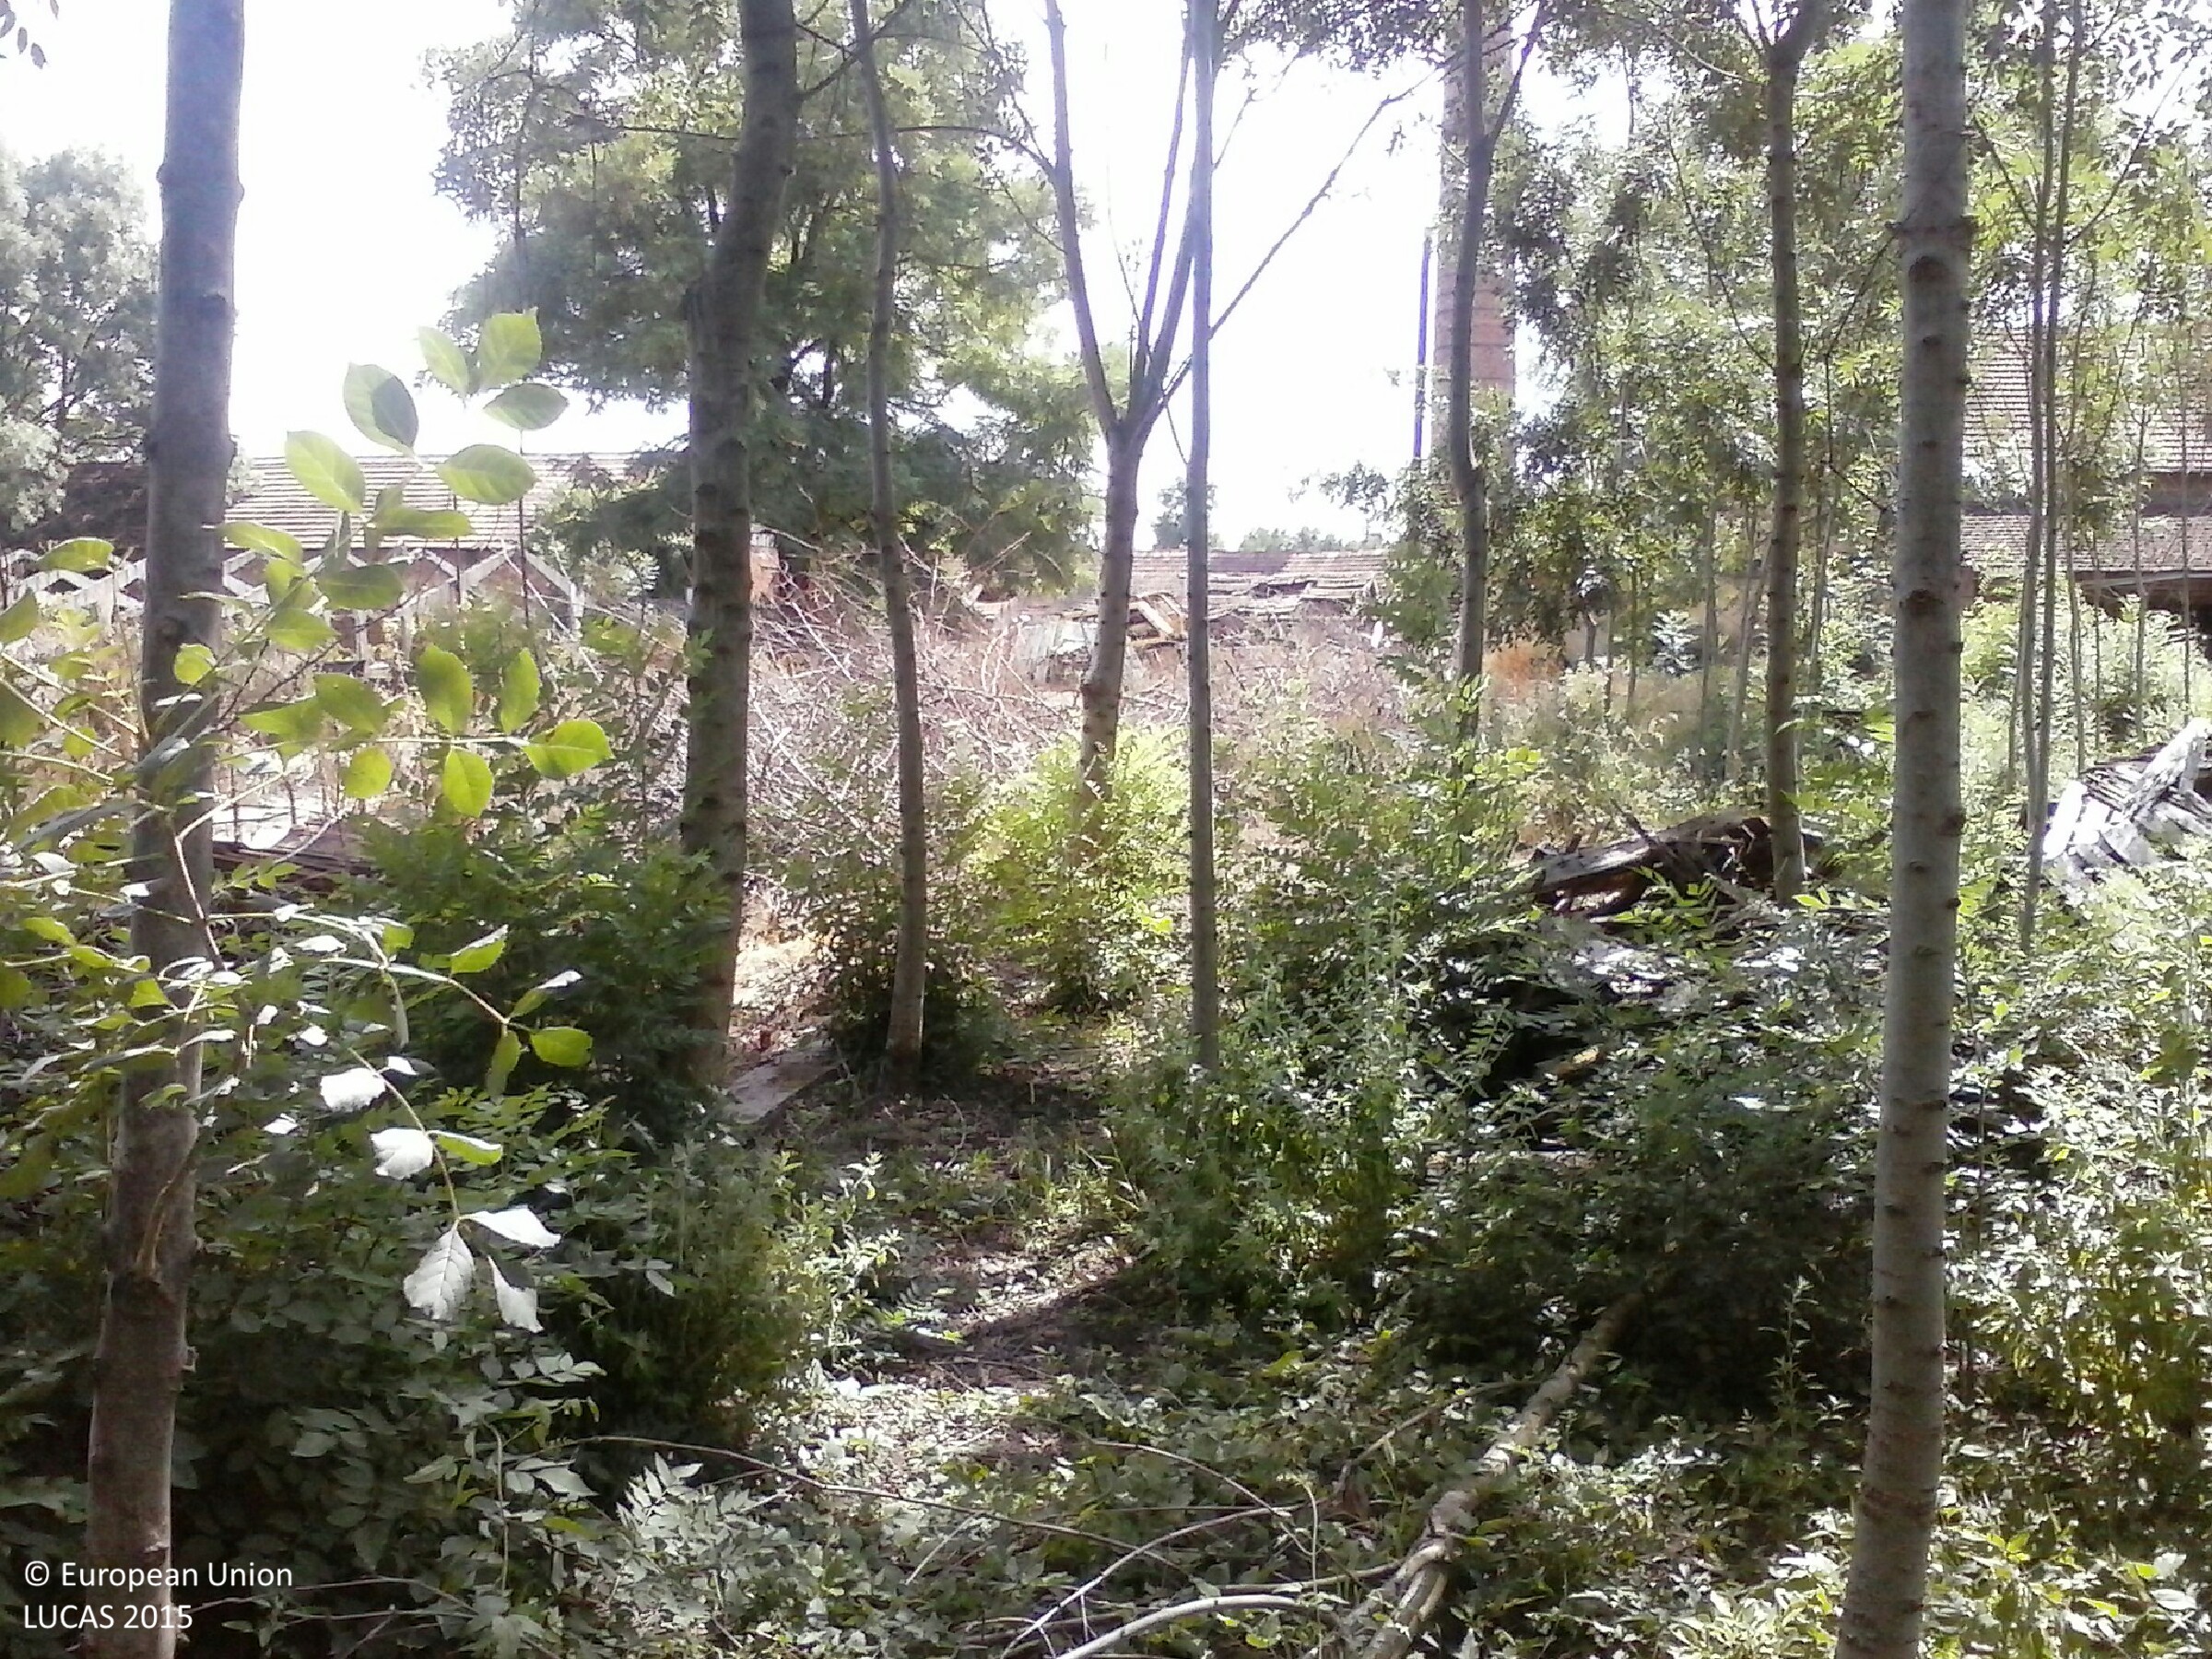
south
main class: Woodland
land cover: Broadleaved woodland
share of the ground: > 75 %
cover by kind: shrubs 80 %, broadleaved forest trees 15 %, herbaceous plants 5 %
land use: Forestry
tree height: < 5 m
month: July
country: HU
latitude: 46.4292
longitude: 20.3442
